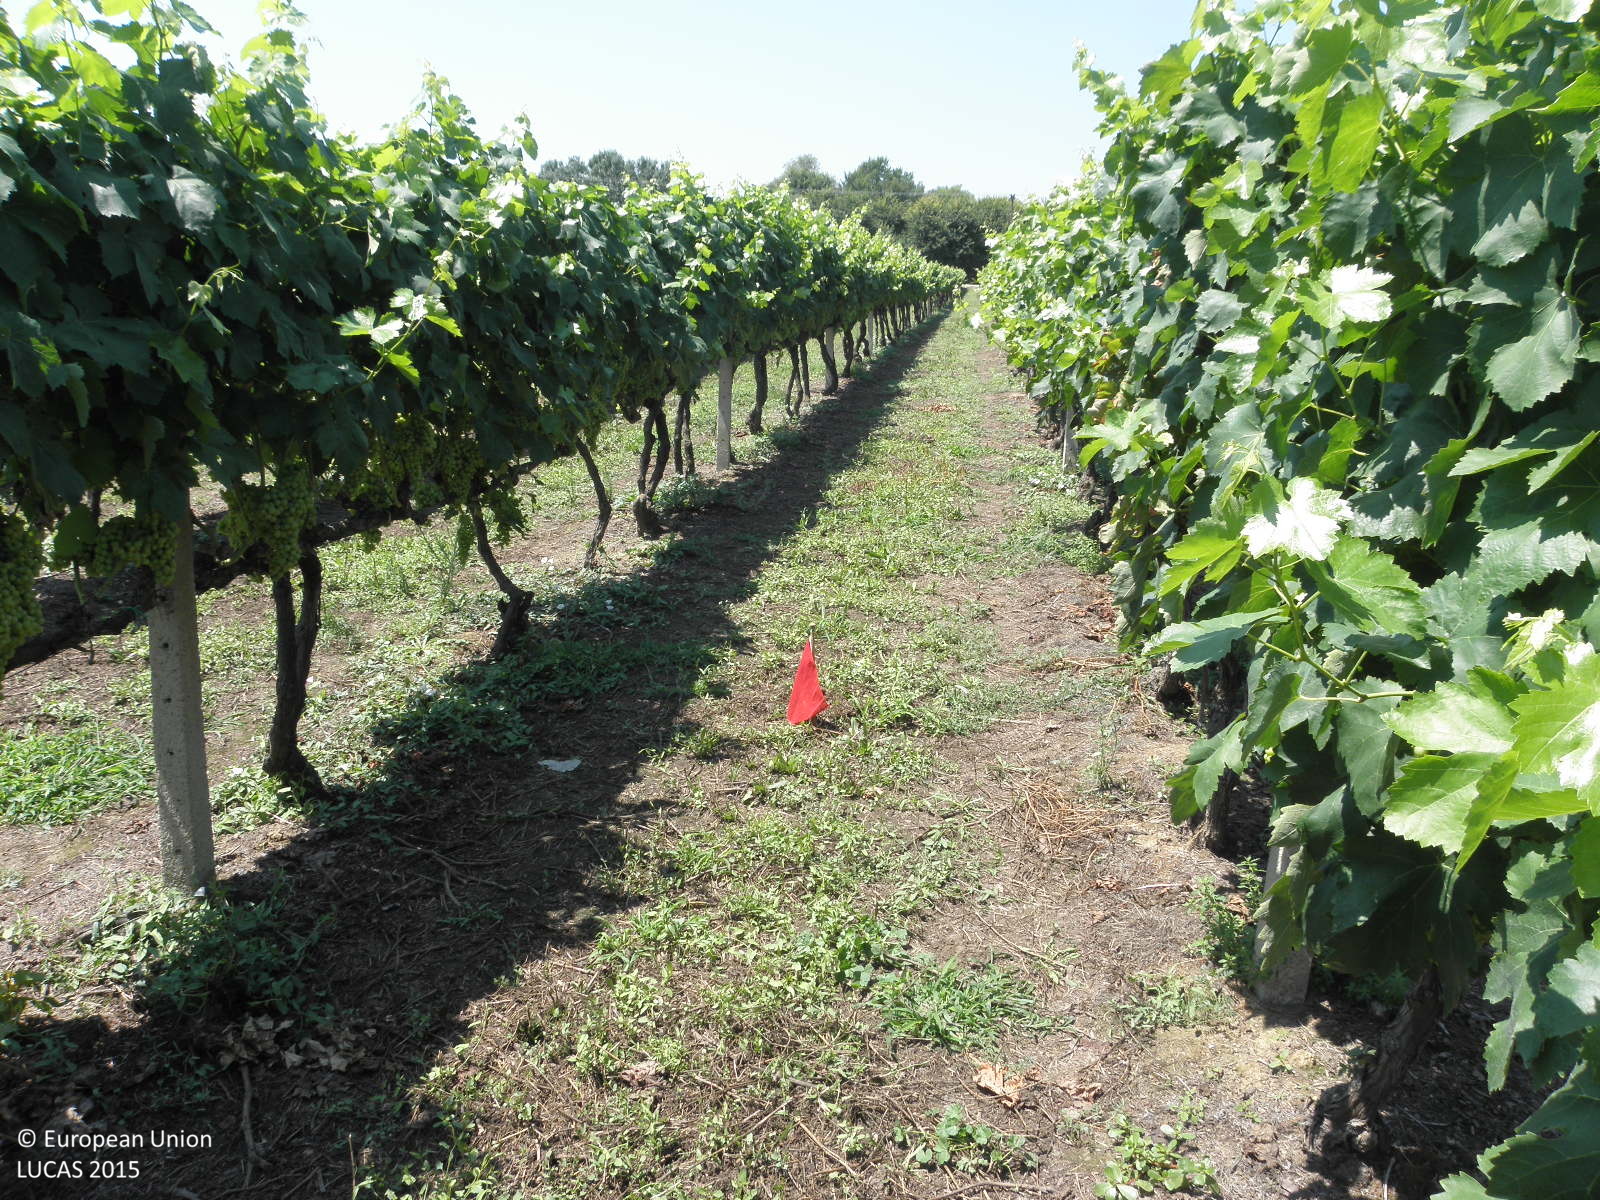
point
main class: Cropland
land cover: Vineyards
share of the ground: > 75 %
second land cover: Grassland without tree/shrub cover
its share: 25 - 50 %
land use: Agriculture (excluding fallow land and kitchen gardens)
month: July
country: GR
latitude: 39.7579
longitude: 22.3515
